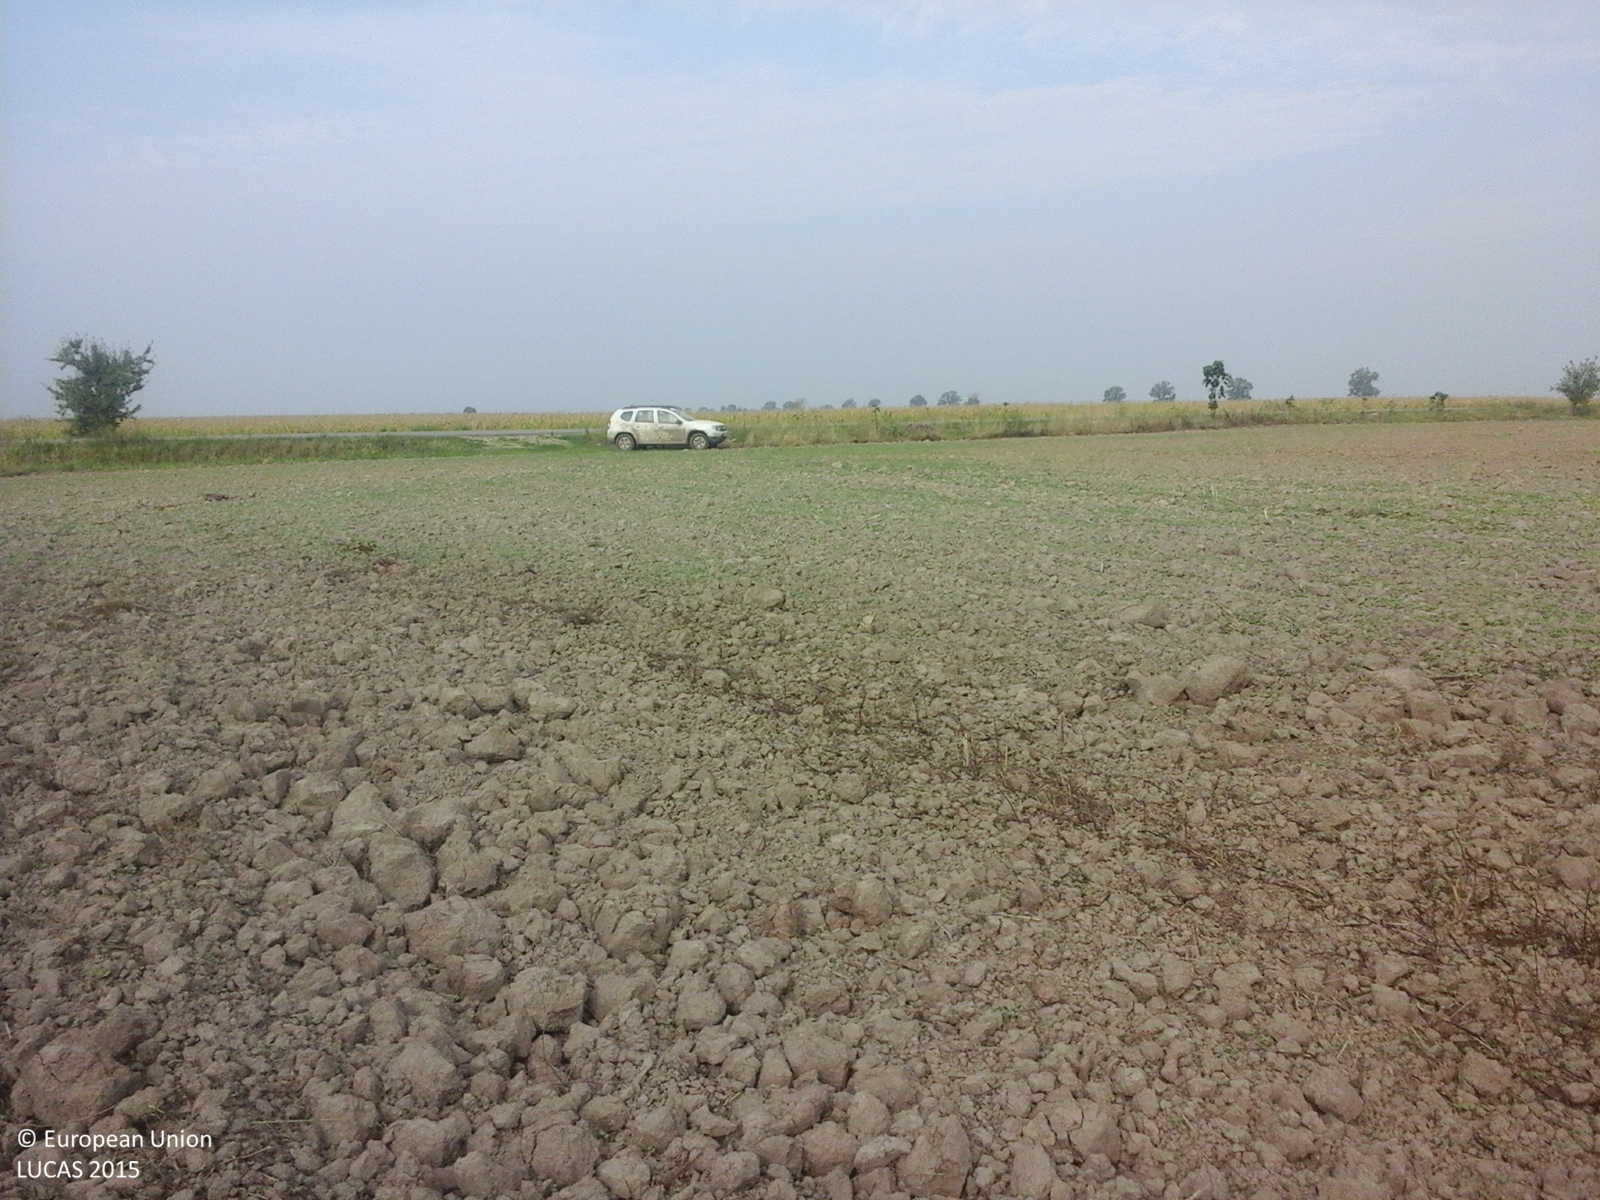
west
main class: Cropland
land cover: Common wheat
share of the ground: < 10 %
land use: Agriculture (excluding fallow land and kitchen gardens)
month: August
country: RO
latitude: 46.3916
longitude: 21.7575
